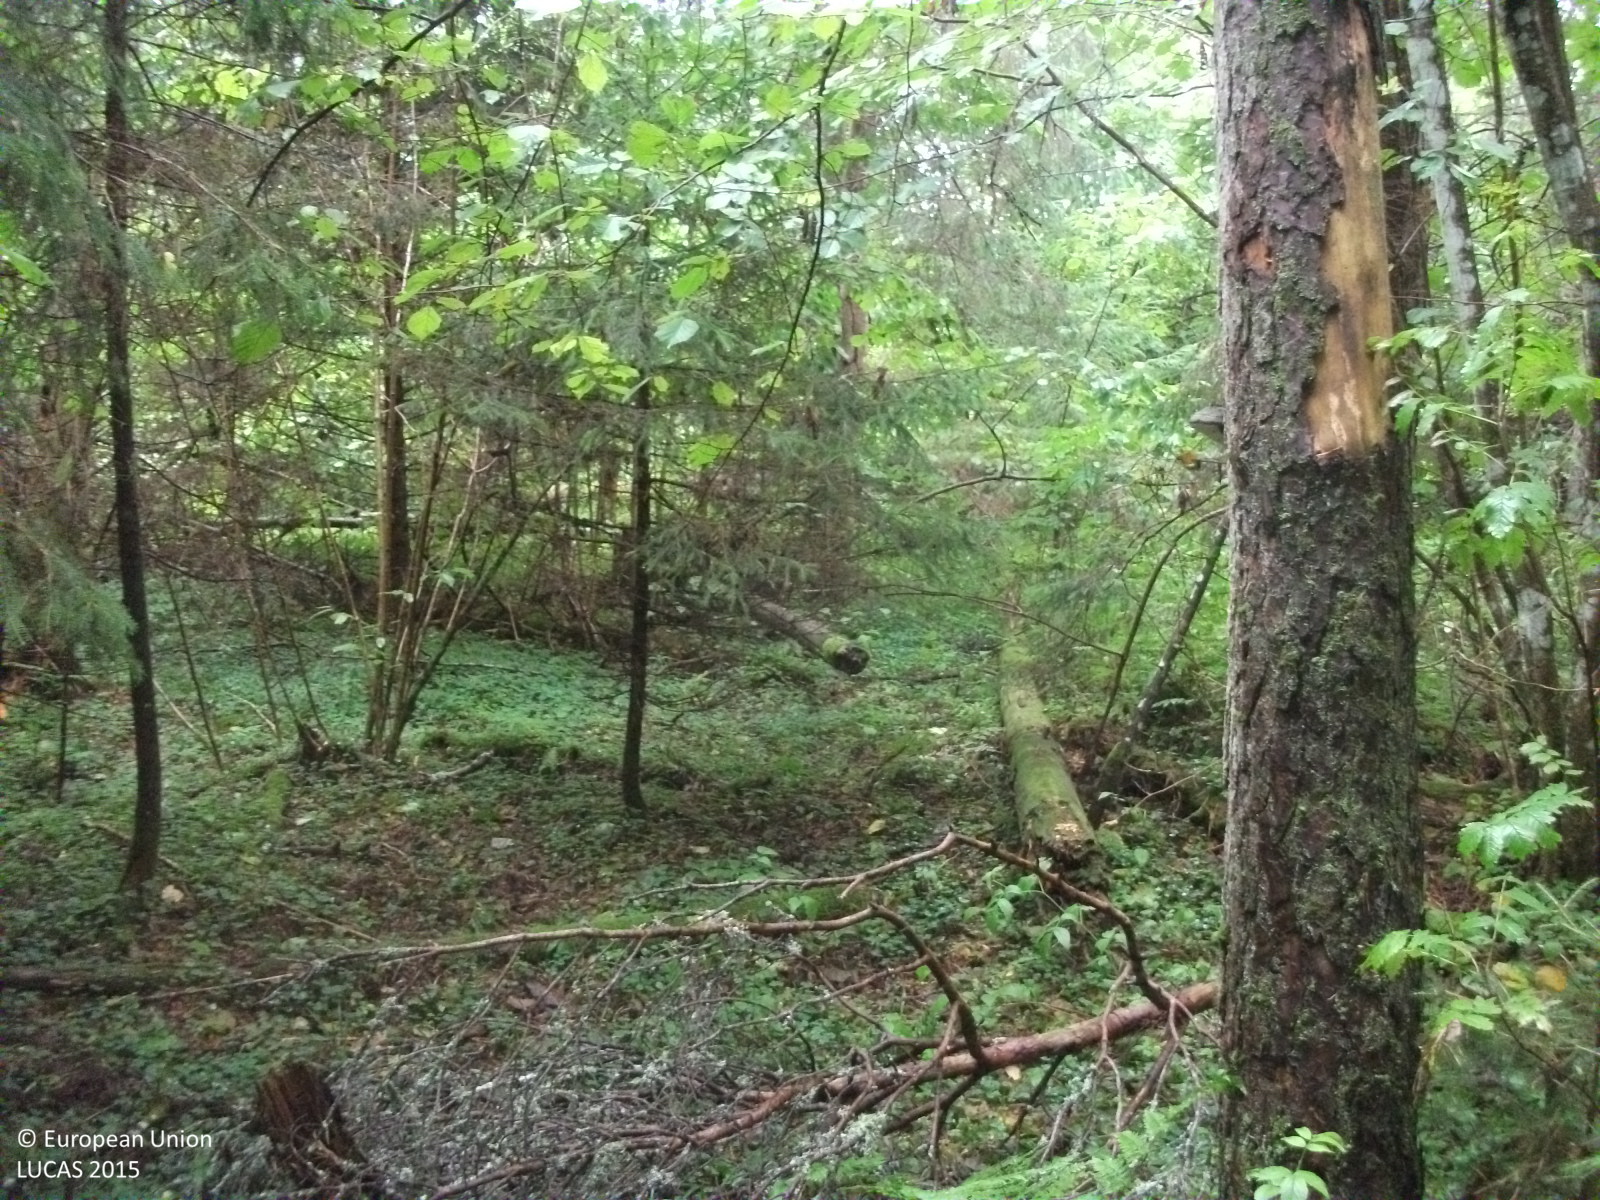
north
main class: Woodland
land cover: Spruce dominated coniferous woodland
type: hemiboreal forest and nemoral coniferous forest and mixed broadleaved-coniferous forest
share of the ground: > 75 %
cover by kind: coniferous forest trees 80 %, broadleaved forest trees 10 %, shrubs 5 %, herbaceous plants 5 %
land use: Forestry
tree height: > 5 m
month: September
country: LV
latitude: 57.5984
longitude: 24.7709
